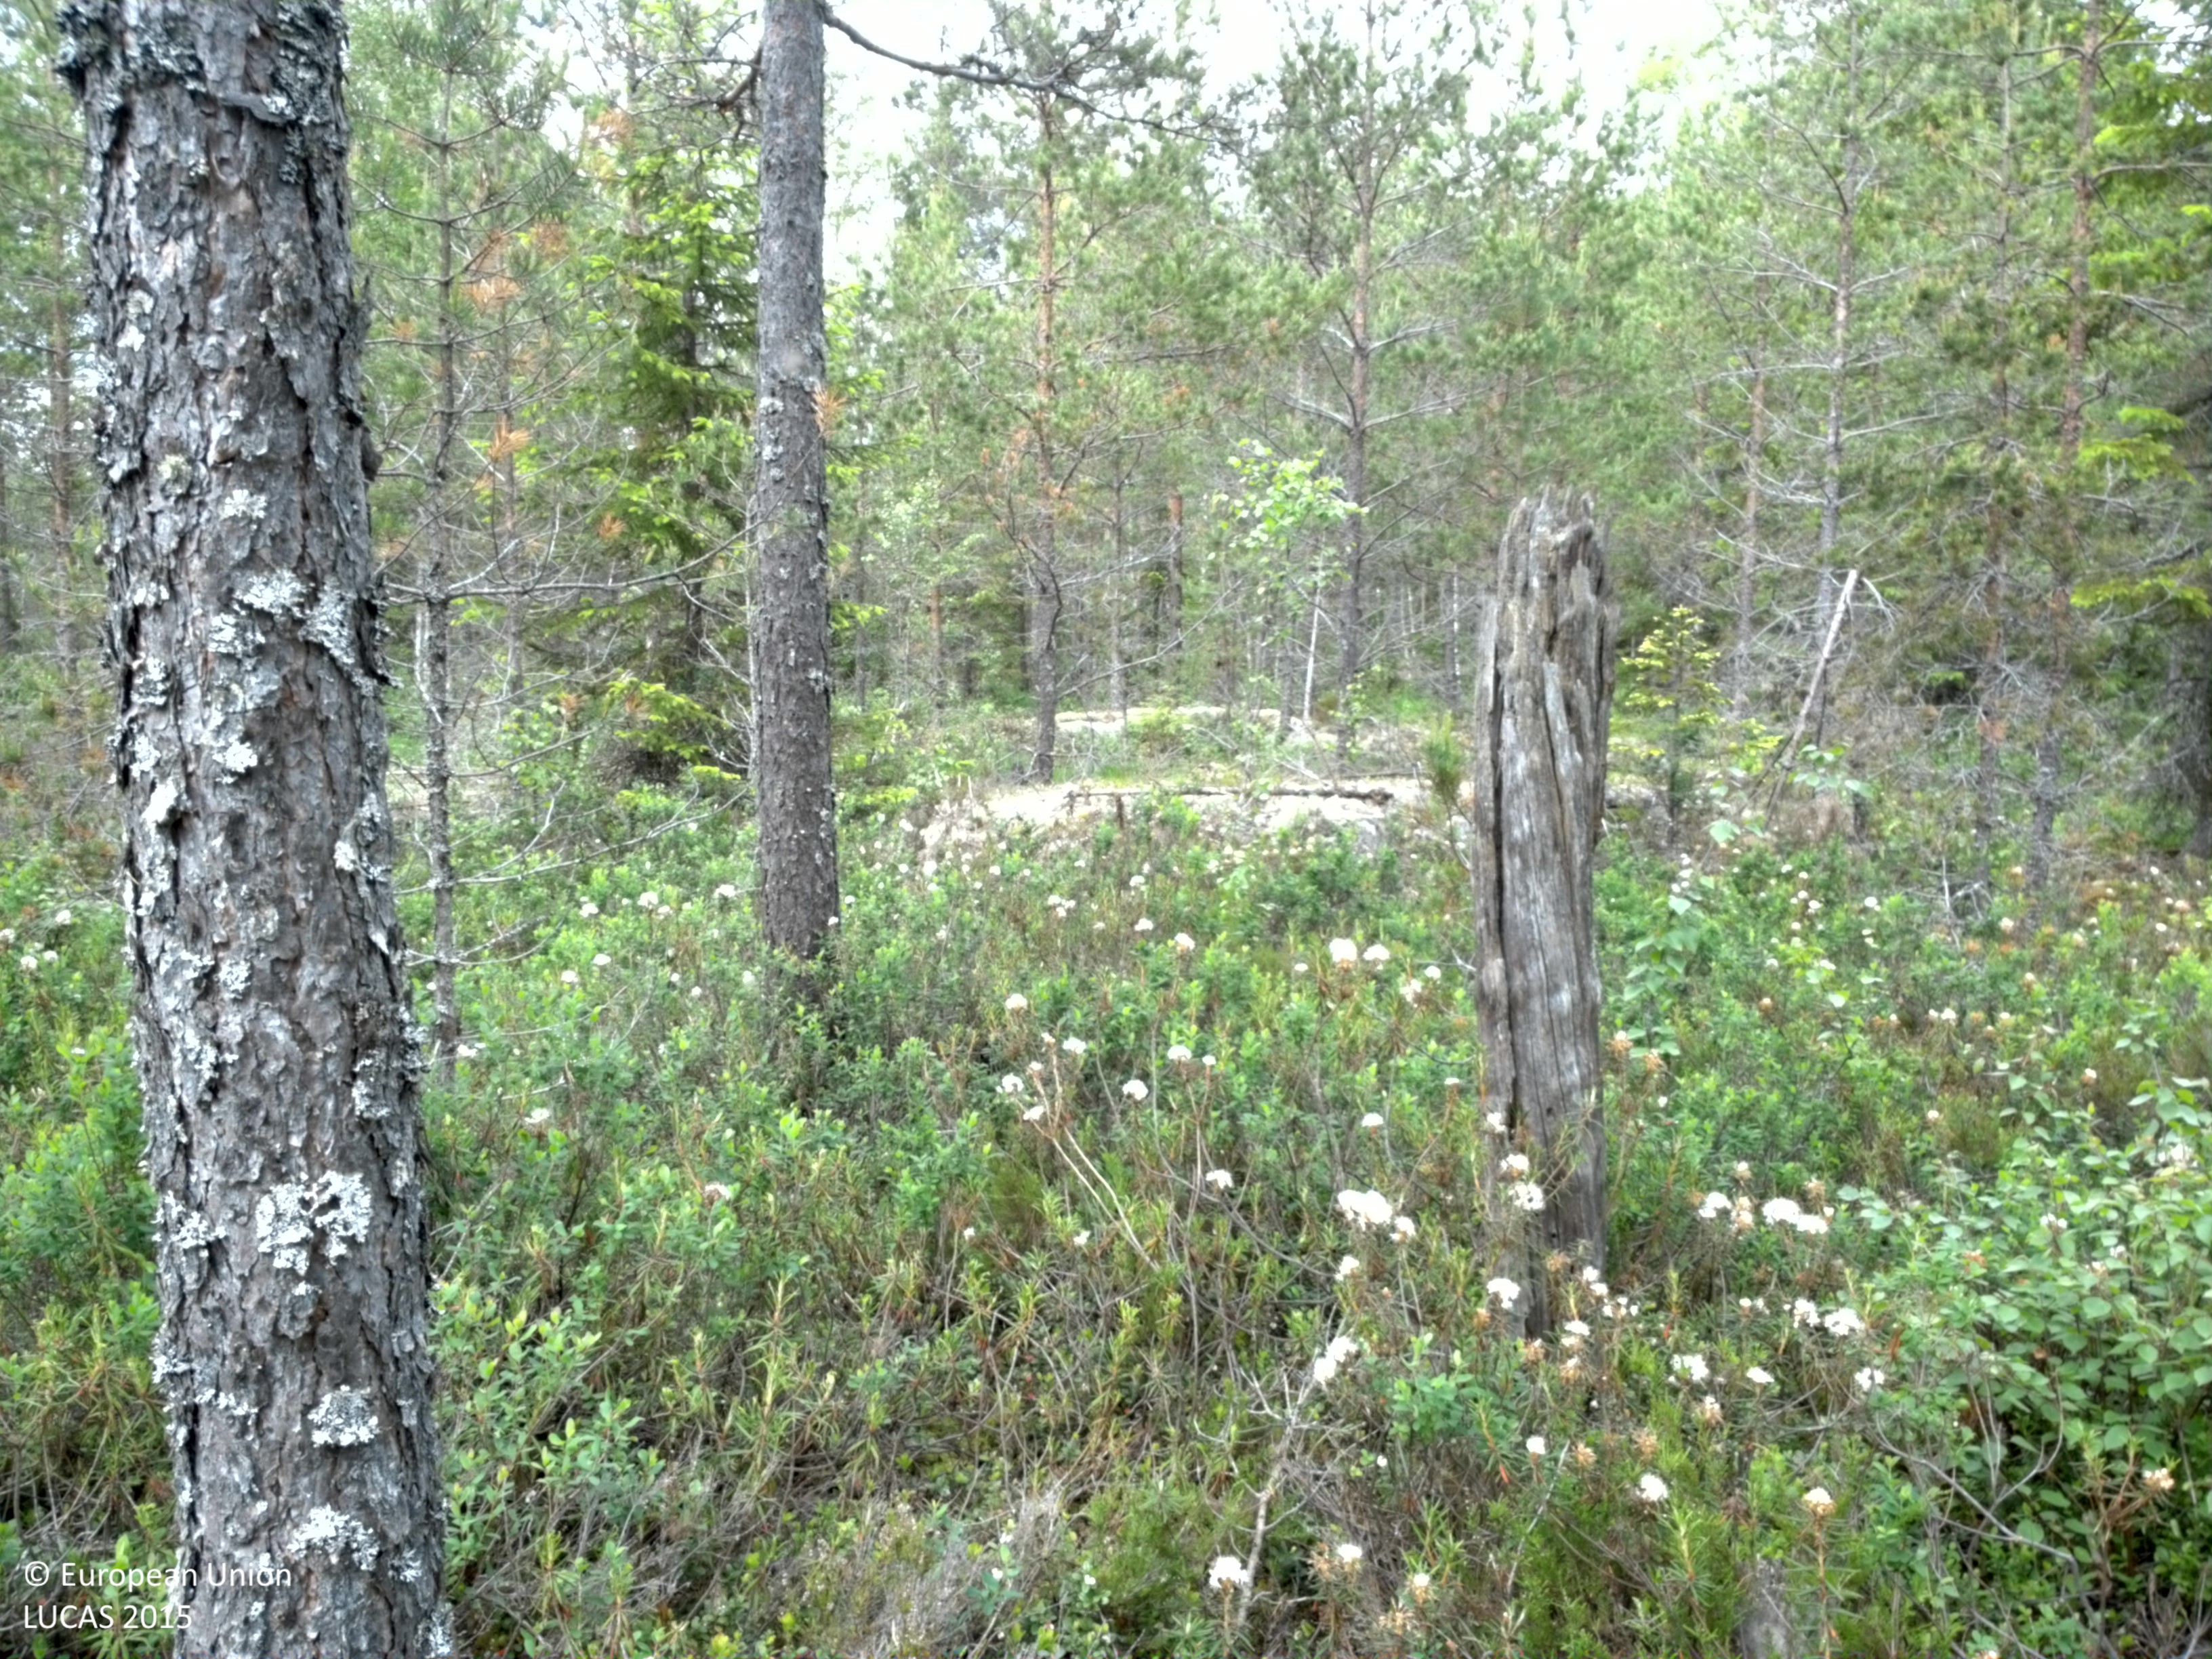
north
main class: Woodland
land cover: Pine dominated coniferous woodland
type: boreal forest
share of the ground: 25 - 50 %
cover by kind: coniferous forest trees 45 %, lichens and mosses 30 %, shrubs 20 %, broadleaved forest trees 5 %
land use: Forestry
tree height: > 5 m
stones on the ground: < 10 %
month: June
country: SE
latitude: 59.9977
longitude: 17.1817
